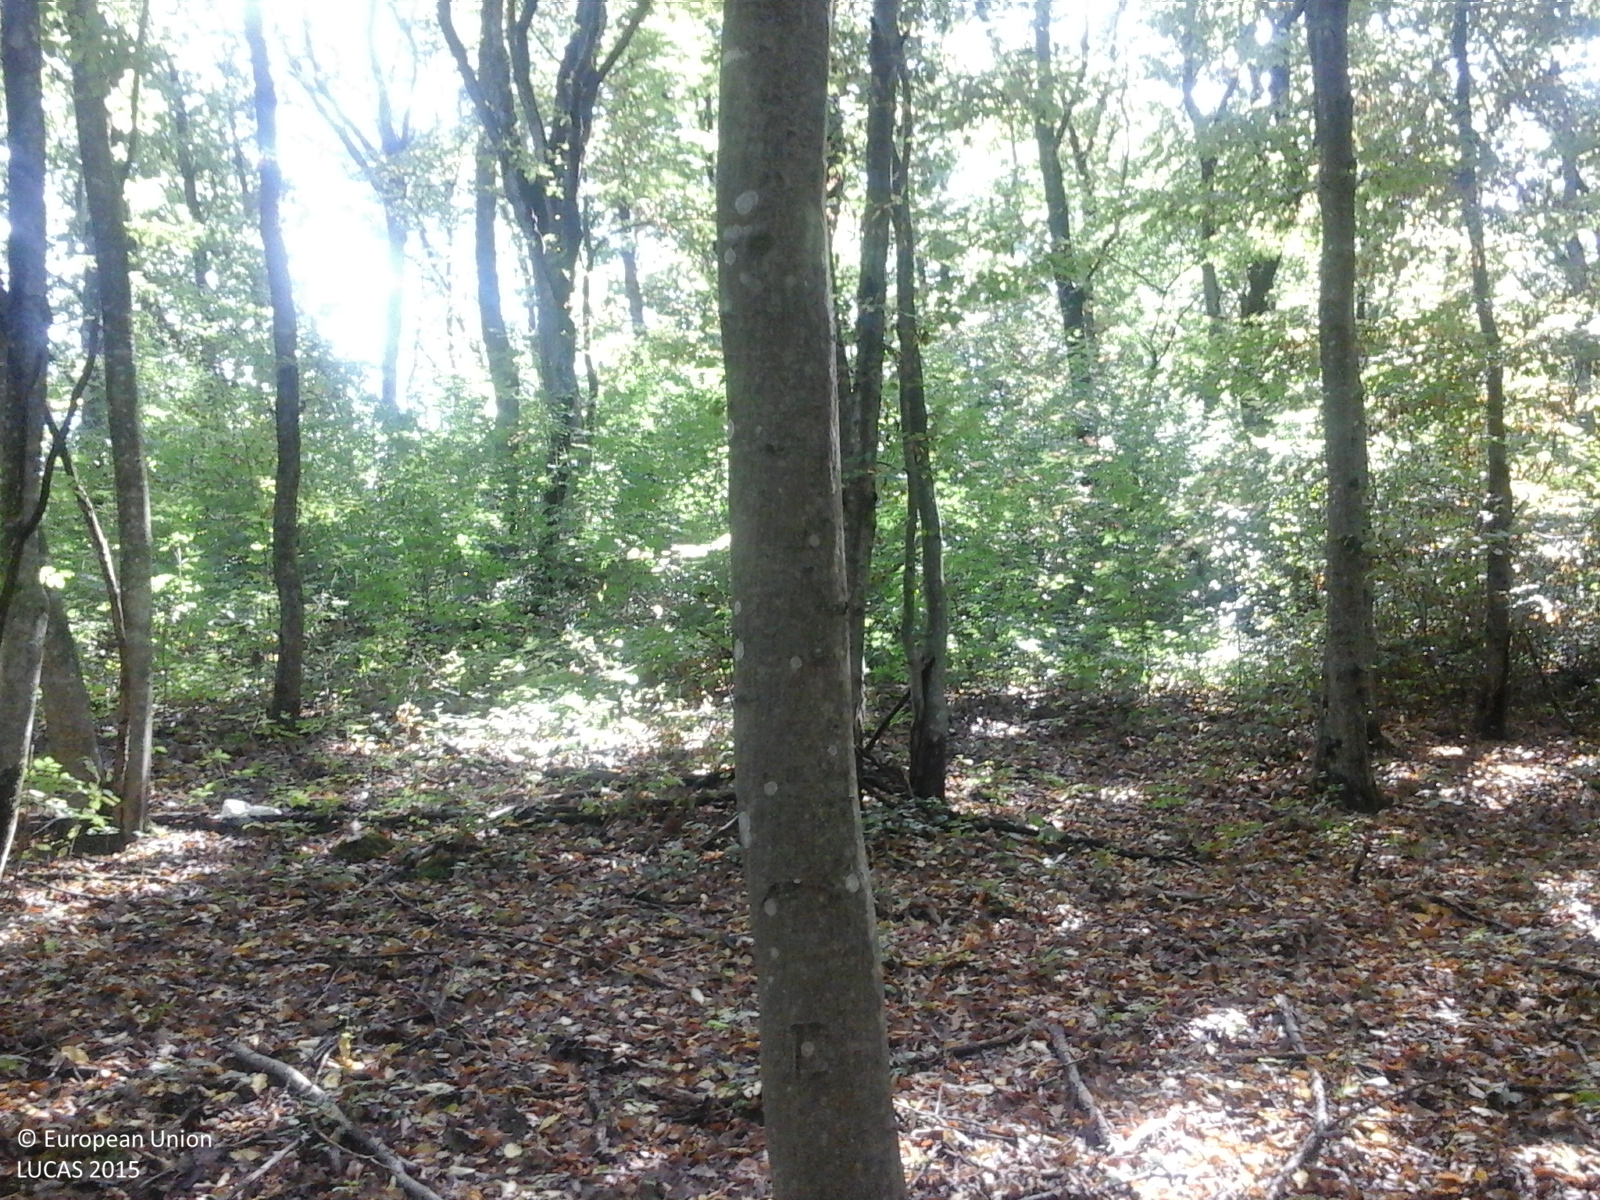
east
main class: Woodland
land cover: Broadleaved woodland
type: beech forest
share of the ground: > 75 %
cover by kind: broadleaved forest trees 100 %
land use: Forestry
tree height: > 5 m
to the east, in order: Broadleaved woodland; Grassland with sparse tree/shrub cover; Broadleaved woodland
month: August
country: RO
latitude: 45.2789
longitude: 21.6202
